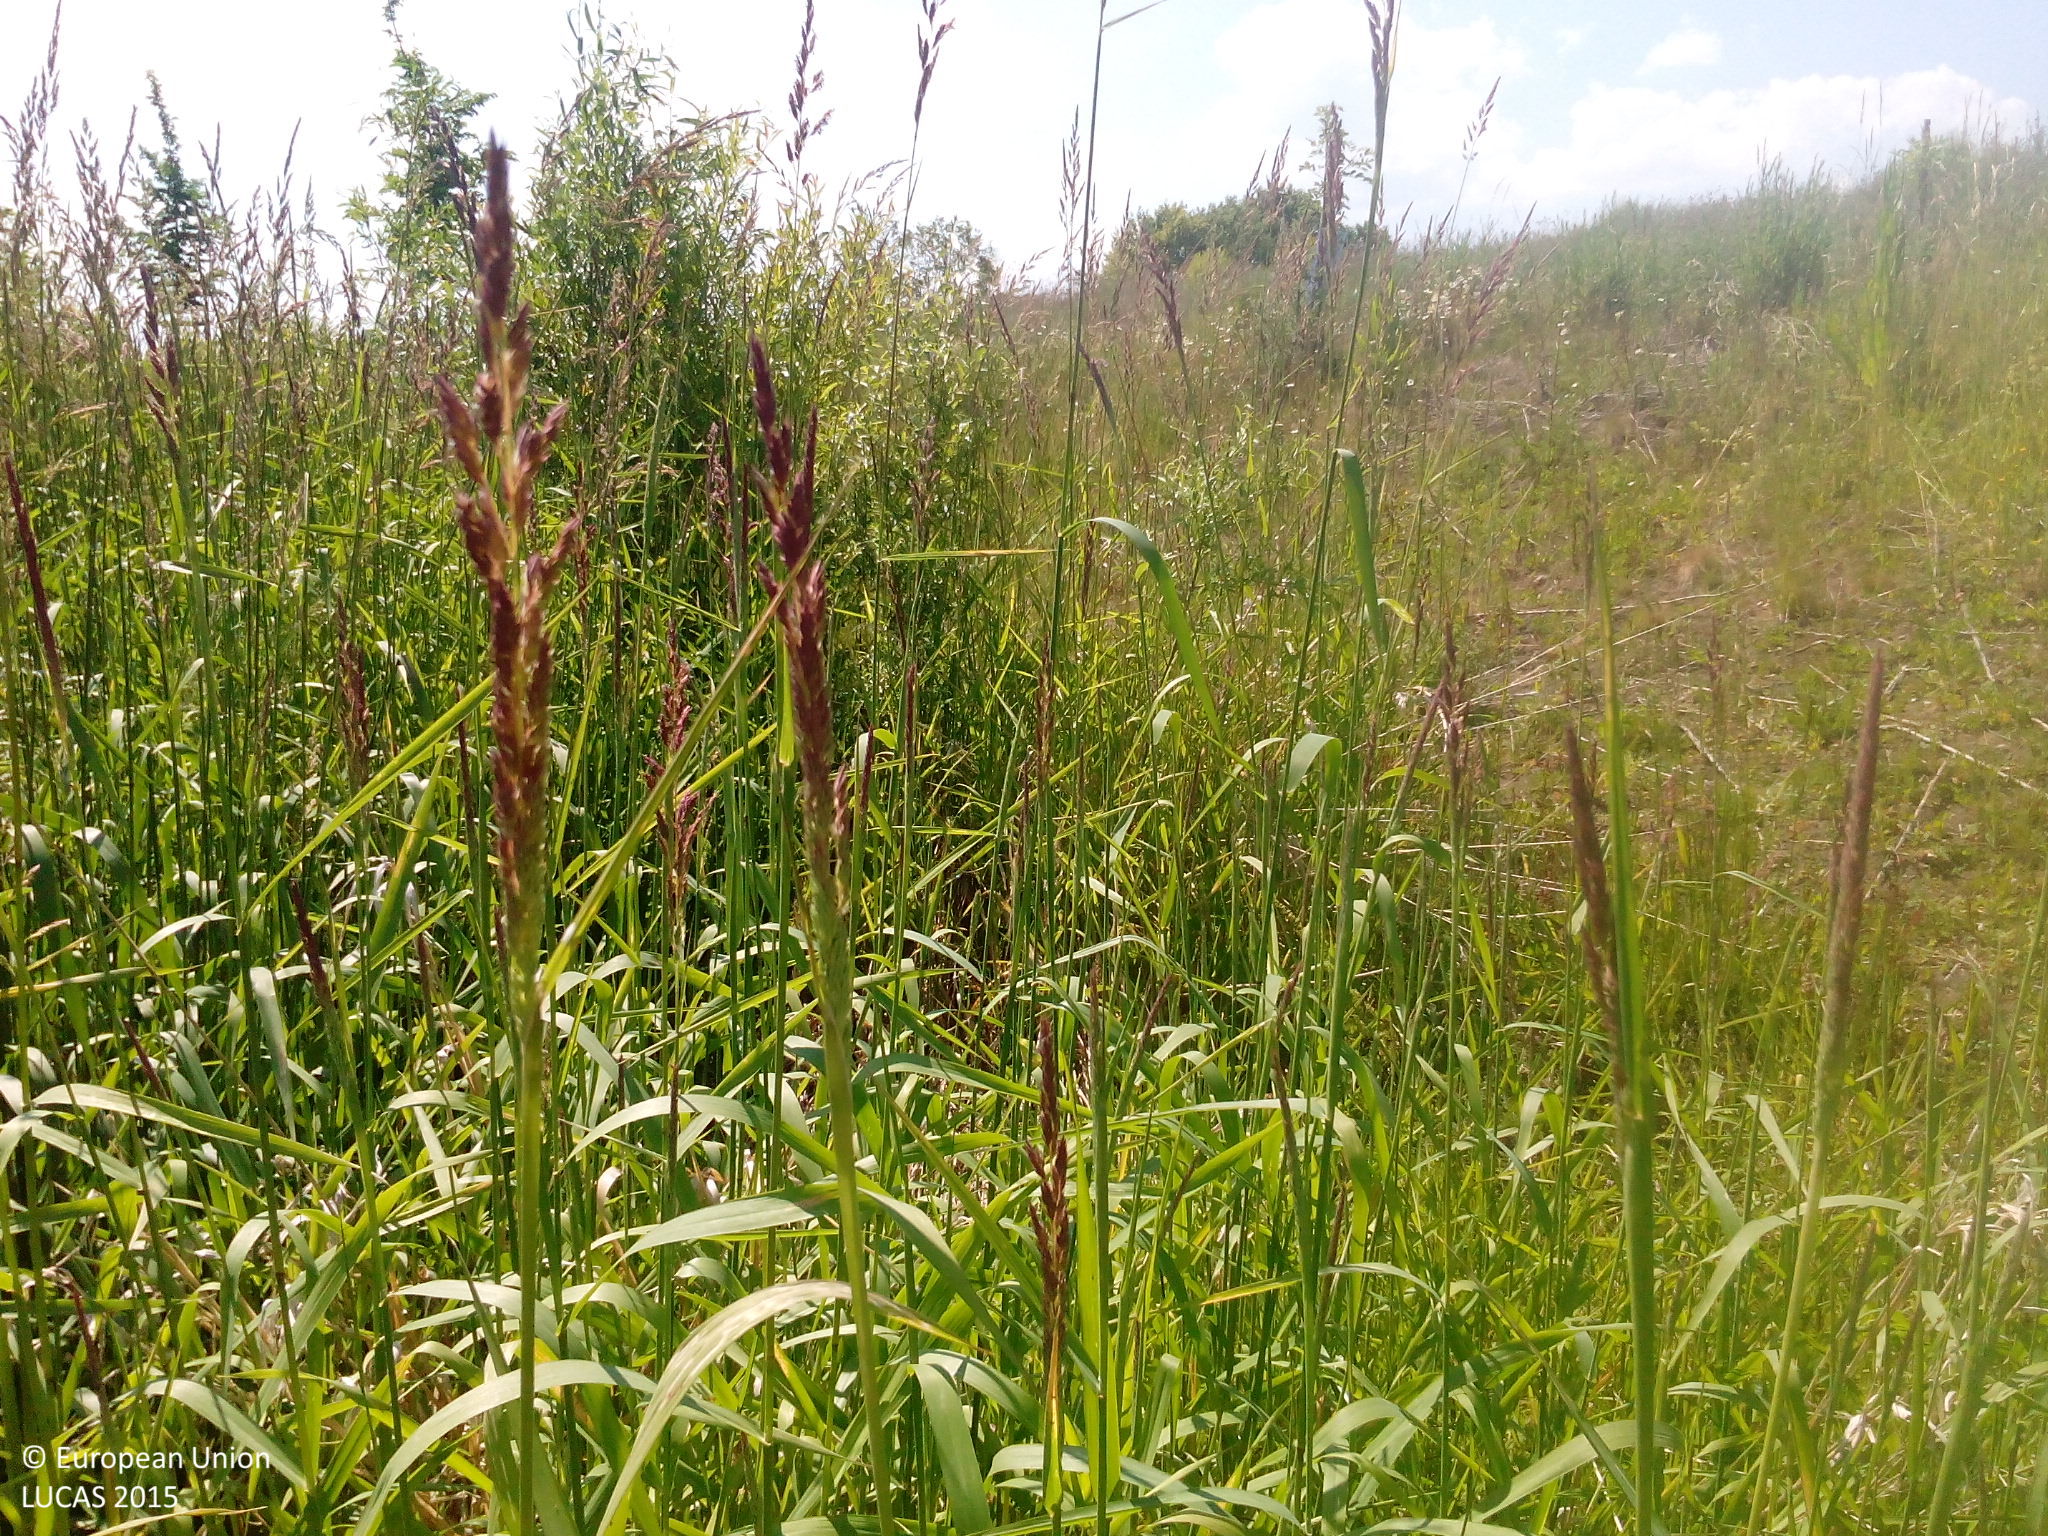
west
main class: Woodland
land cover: Broadleaved woodland
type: floodplain forest
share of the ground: 50 - 75 %
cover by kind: broadleaved forest trees 50 %, herbaceous plants 30 %, shrubs 20 %
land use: Semi-natural and natural areas not in use
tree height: < 5 m
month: June
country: DE
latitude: 49.7556
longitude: 8.1543
